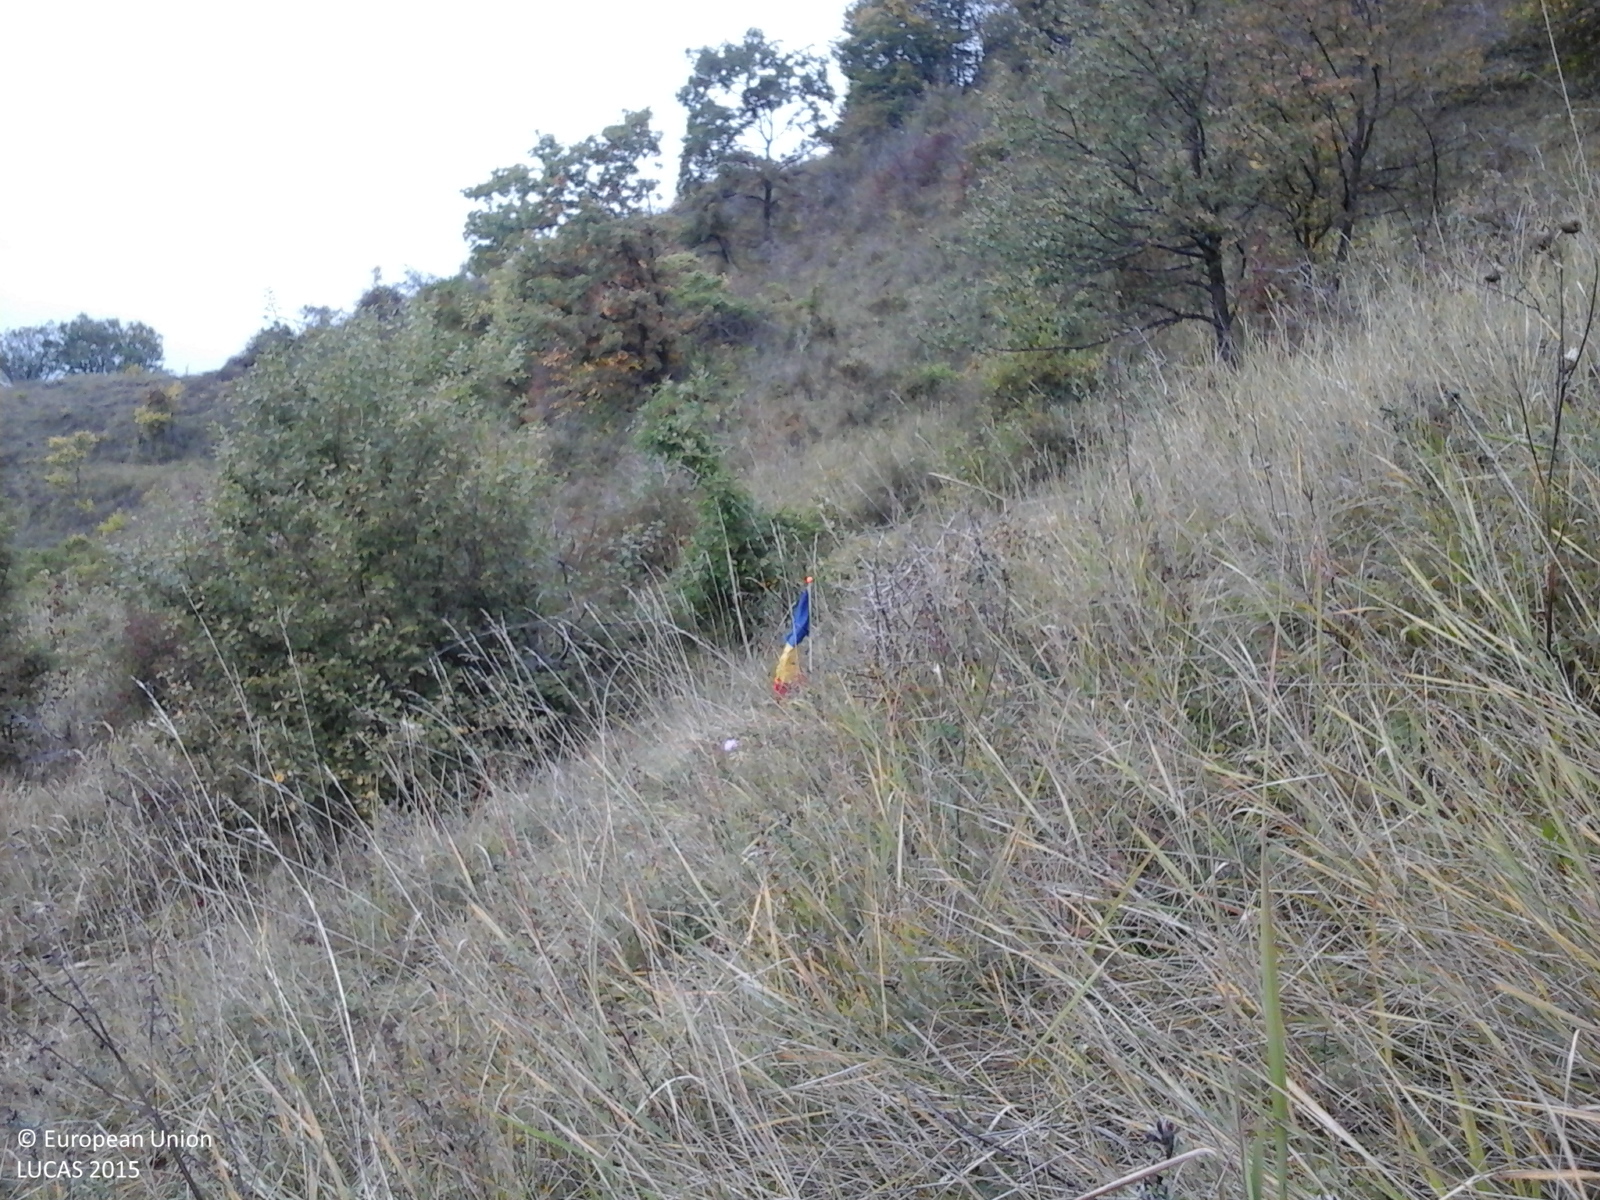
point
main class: Grassland
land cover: Grassland with sparse tree/shrub cover
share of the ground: > 75 %
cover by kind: herbaceous plants 85 %, shrubs 10 %, broadleaved forest trees 5 %
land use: Agriculture (excluding fallow land and kitchen gardens)
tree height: < 5 m
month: October
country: RO
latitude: 46.3373
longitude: 24.9444
